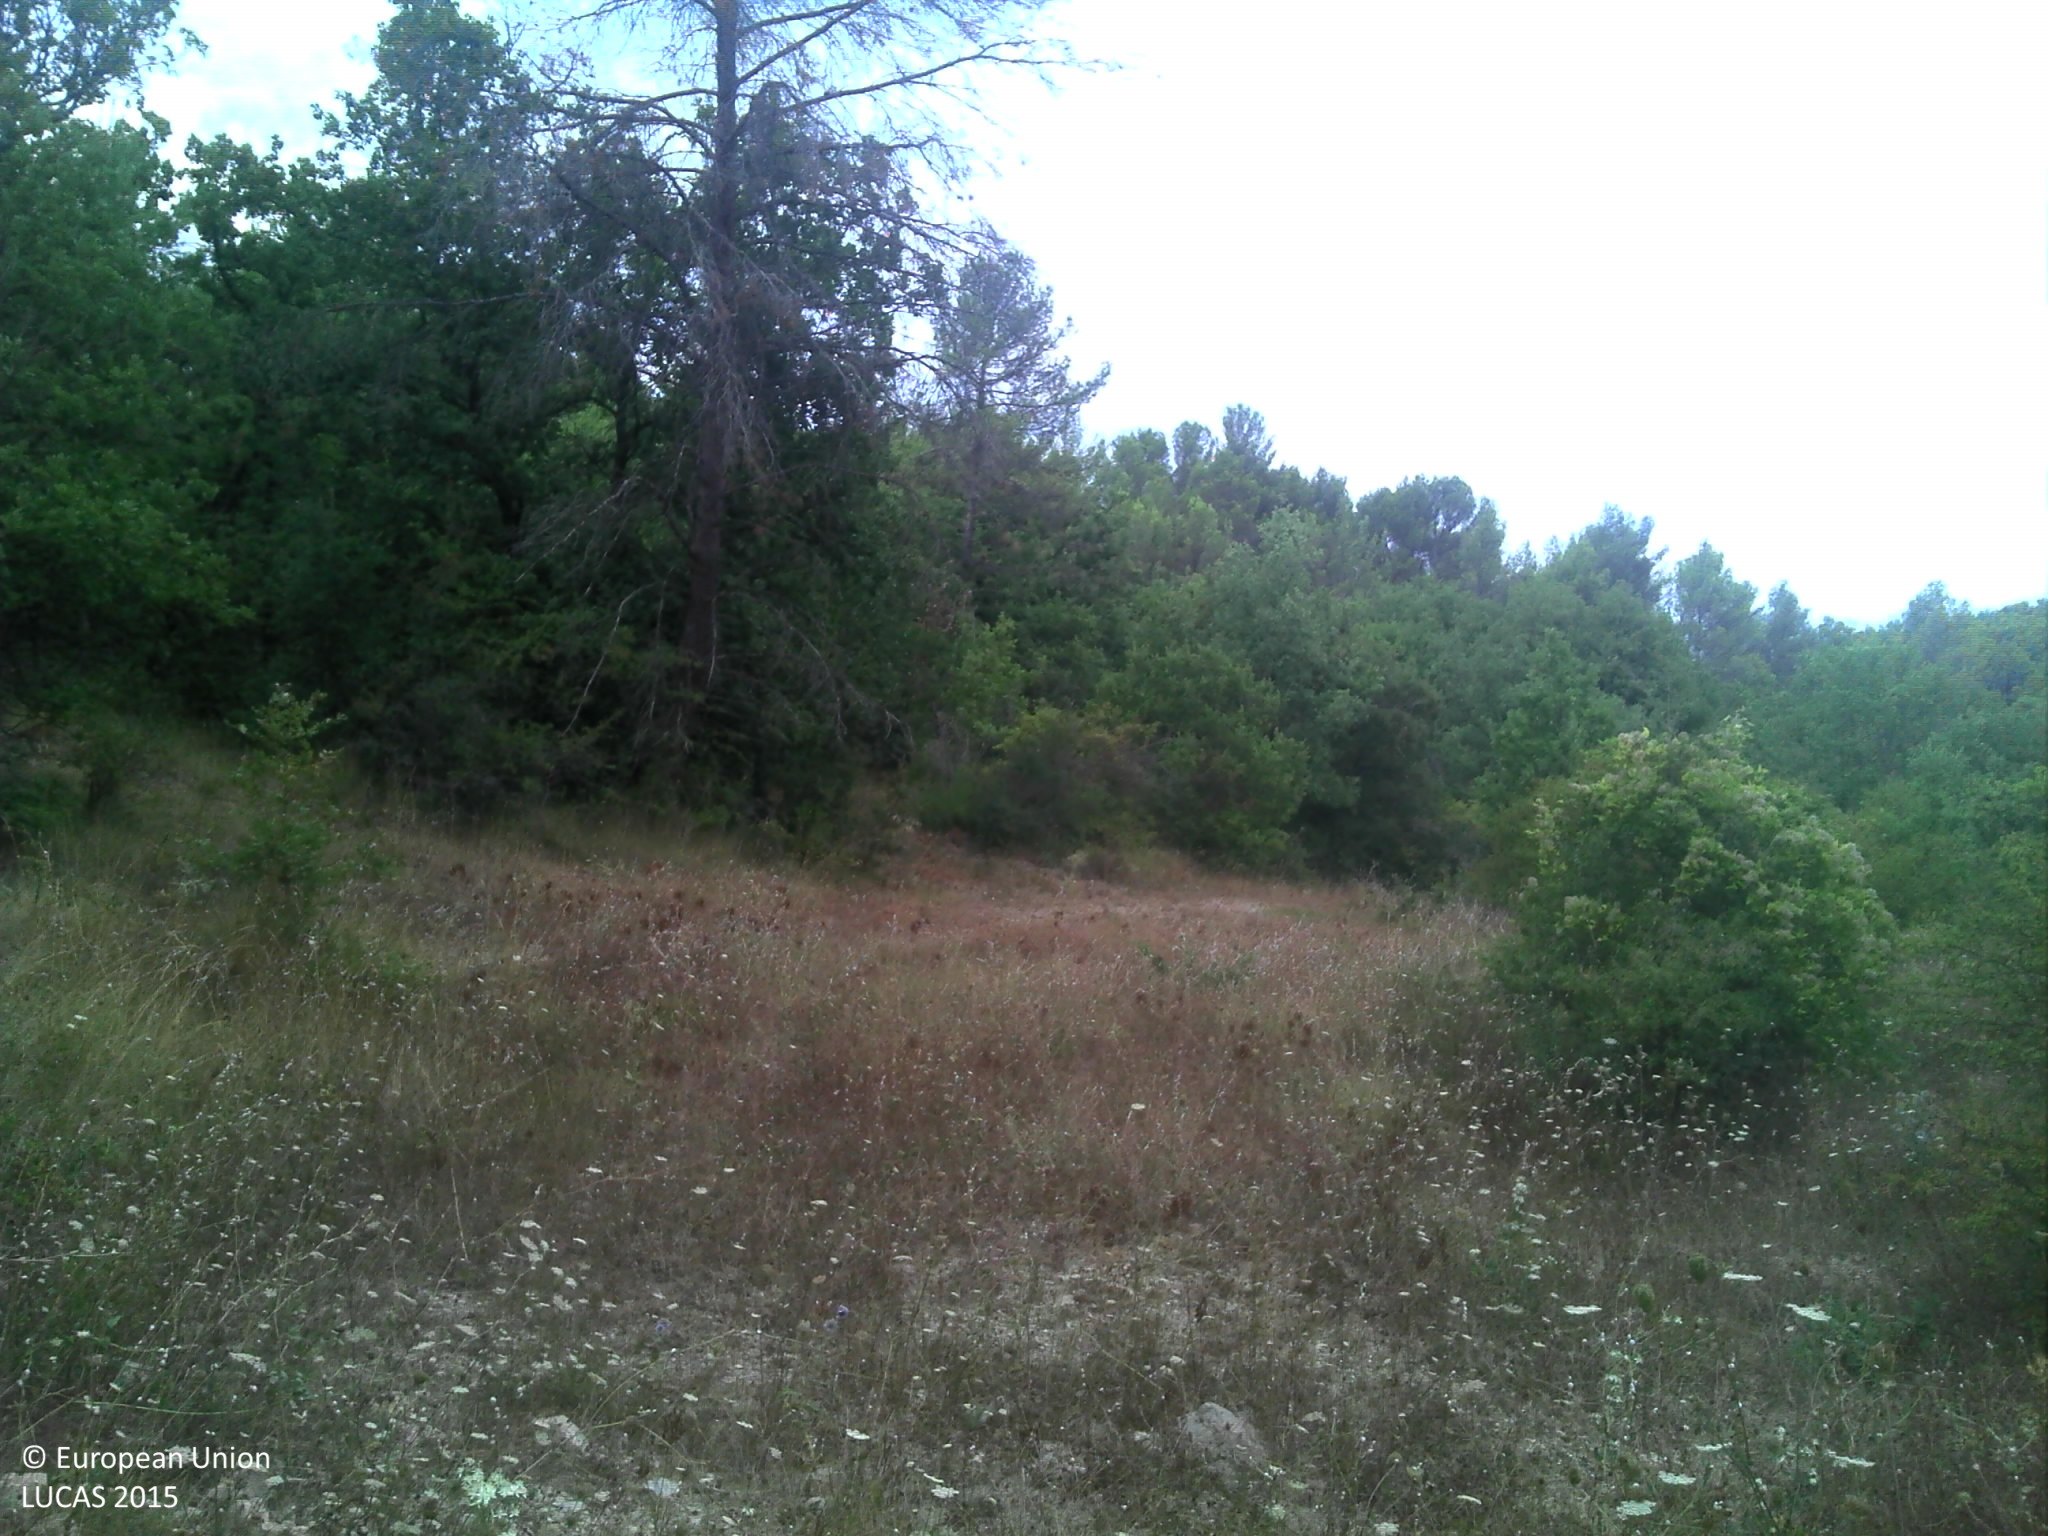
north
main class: Woodland
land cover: Pine dominated mixed woodland
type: coniferous forest of the mediterranean region
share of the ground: > 75 %
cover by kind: coniferous forest trees 45 %, broadleaved forest trees 30 %, shrubs 25 %
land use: Sport
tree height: < 5 m
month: August
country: FR
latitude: 43.4251
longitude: 5.5754
